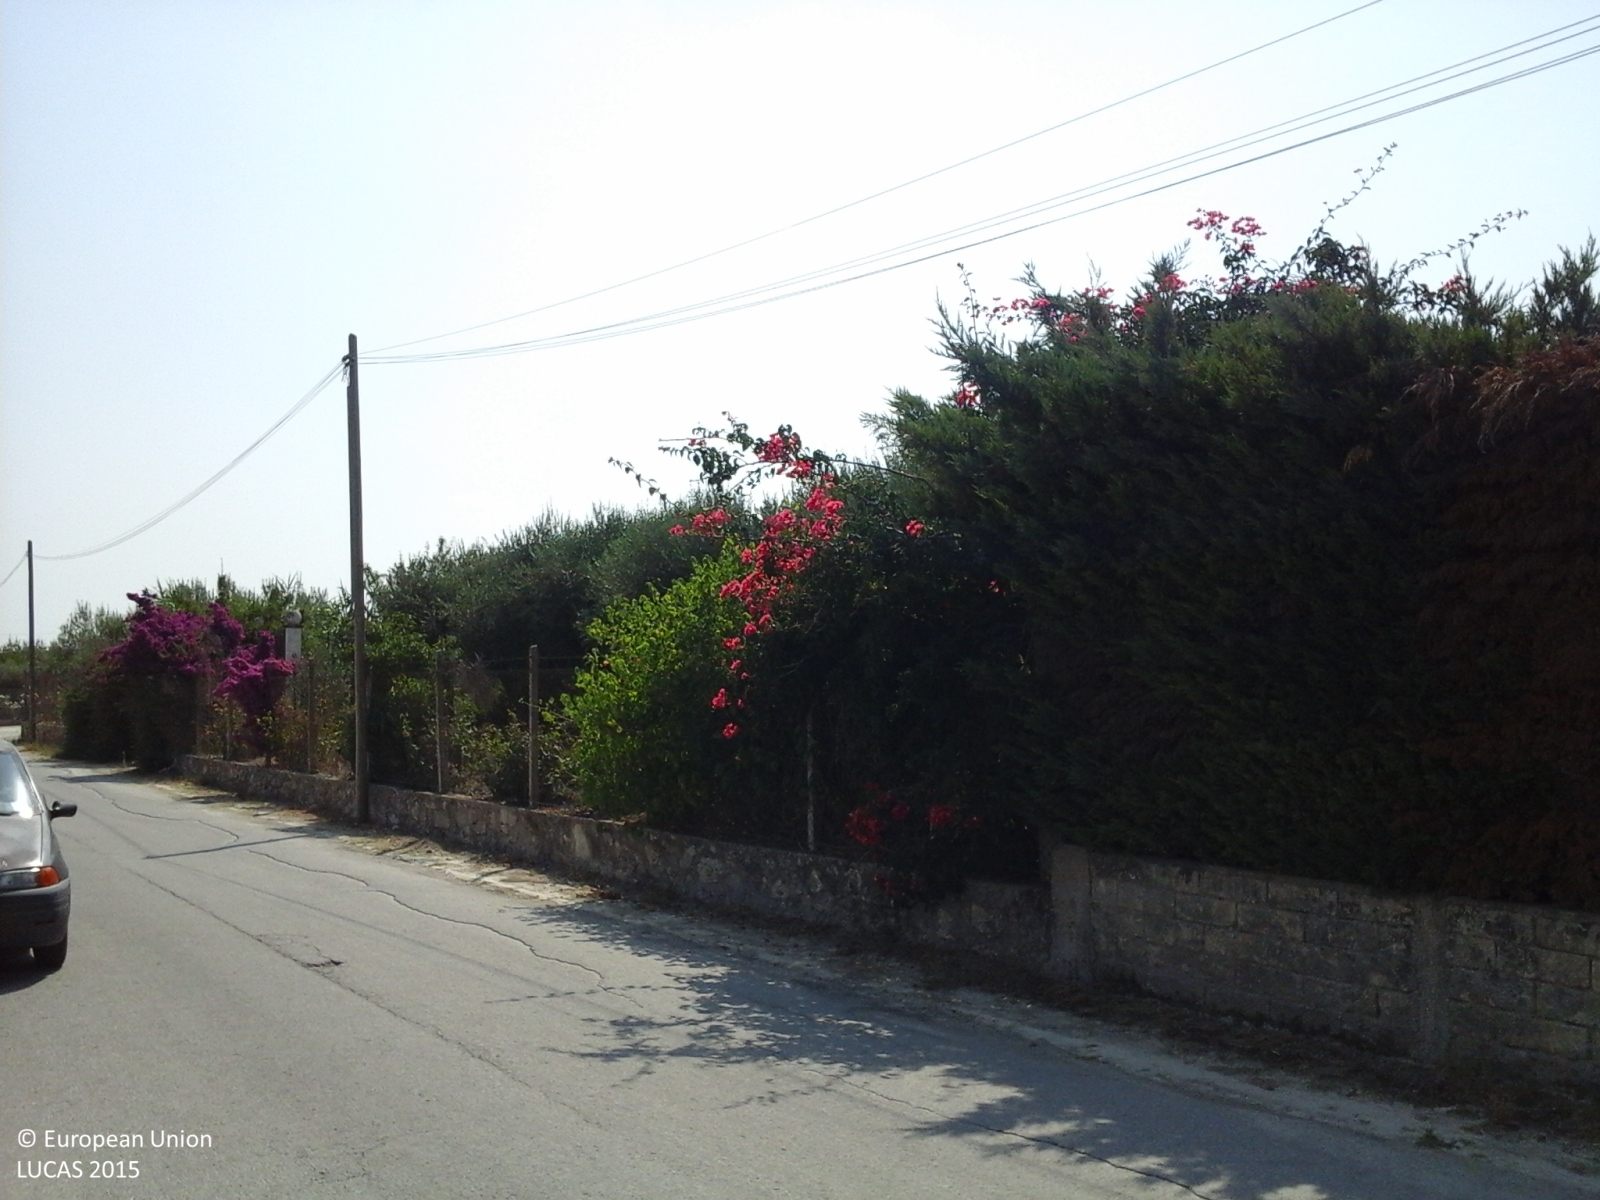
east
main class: Cropland
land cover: Vineyards
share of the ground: > 75 %
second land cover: Other bare soil
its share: > 75 %
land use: Agriculture (excluding fallow land and kitchen gardens)
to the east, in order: Vineyards; Other bare soil; Other citrus fruit; Vineyards; Fences; Other fruit trees and berries; Nuts trees; Fences; Paved roads, cycling and walking lanes; Fences; Spontaneously vegetated surfaces
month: July
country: IT
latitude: 37.2493
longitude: 13.9042
